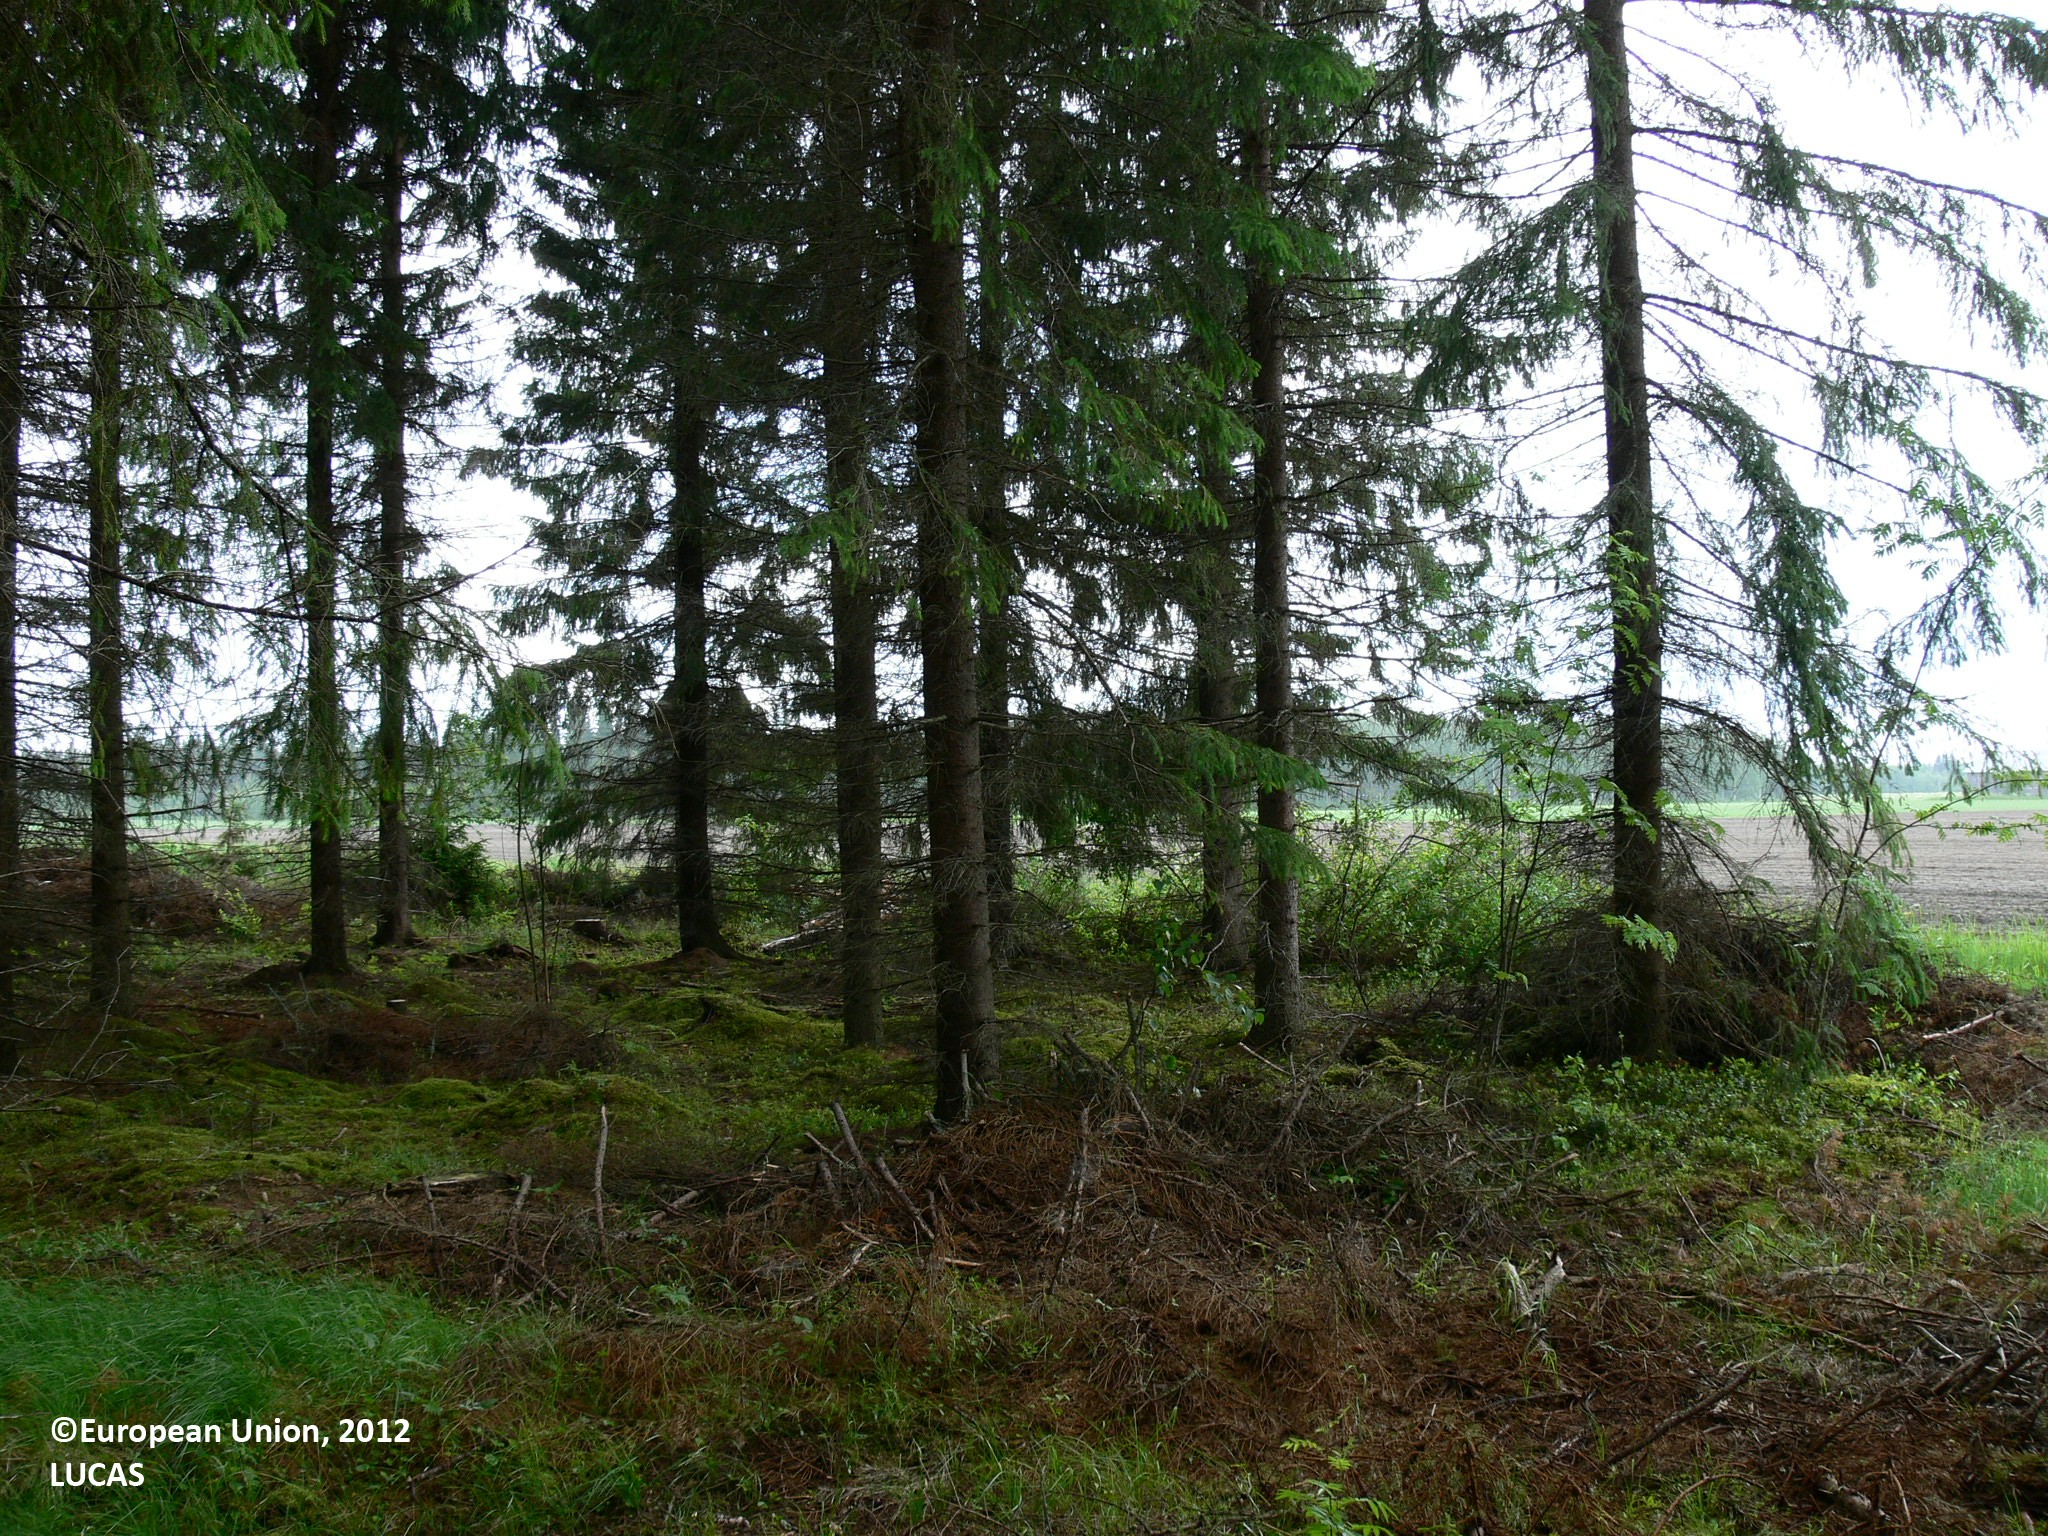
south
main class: Woodland
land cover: Spruce dominated coniferous woodland
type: boreal forest
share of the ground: 50 - 75 %
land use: Forestry
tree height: > 5 m
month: June
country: FI
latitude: 62.5780
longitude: 29.5685
